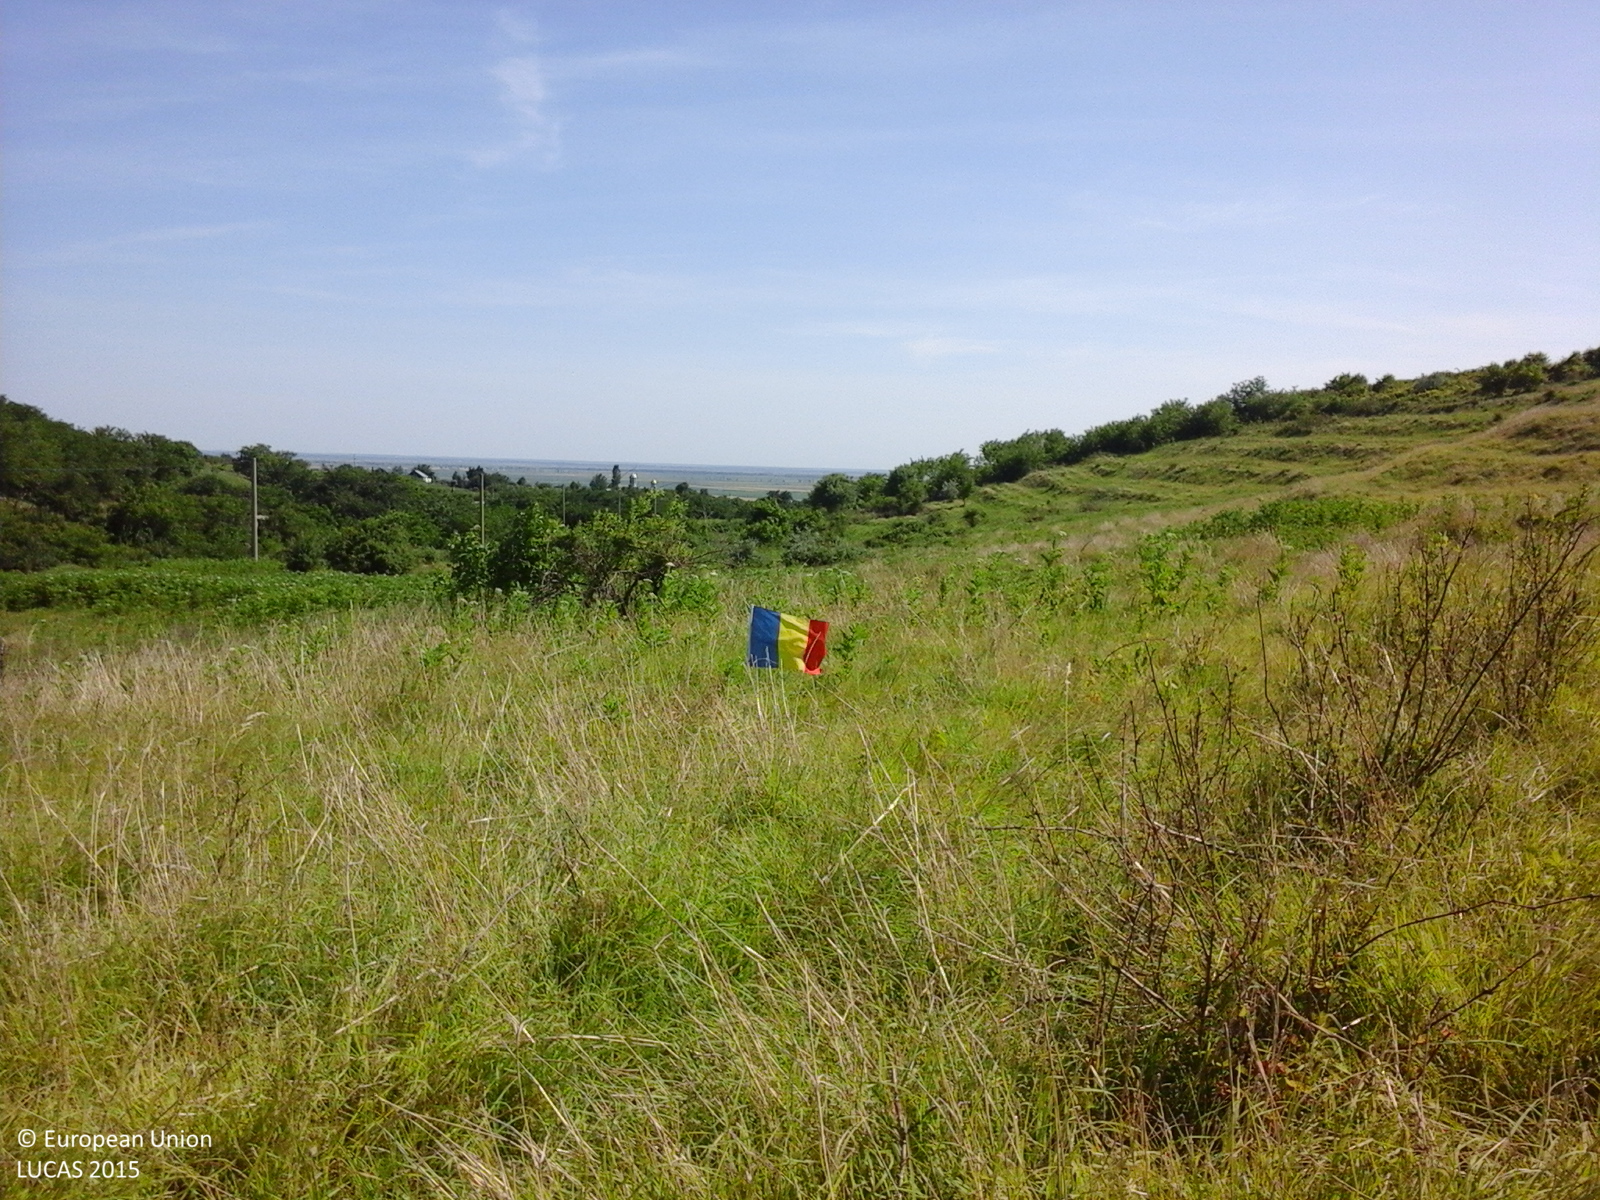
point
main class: Grassland
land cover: Grassland with sparse tree/shrub cover
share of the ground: > 75 %
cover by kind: herbaceous plants 90 %, coniferous forest trees 5 %, shrubs 5 %
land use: Agriculture (excluding fallow land and kitchen gardens)
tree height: < 5 m
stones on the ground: < 10 %
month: June
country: RO
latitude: 45.0038
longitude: 26.2650
